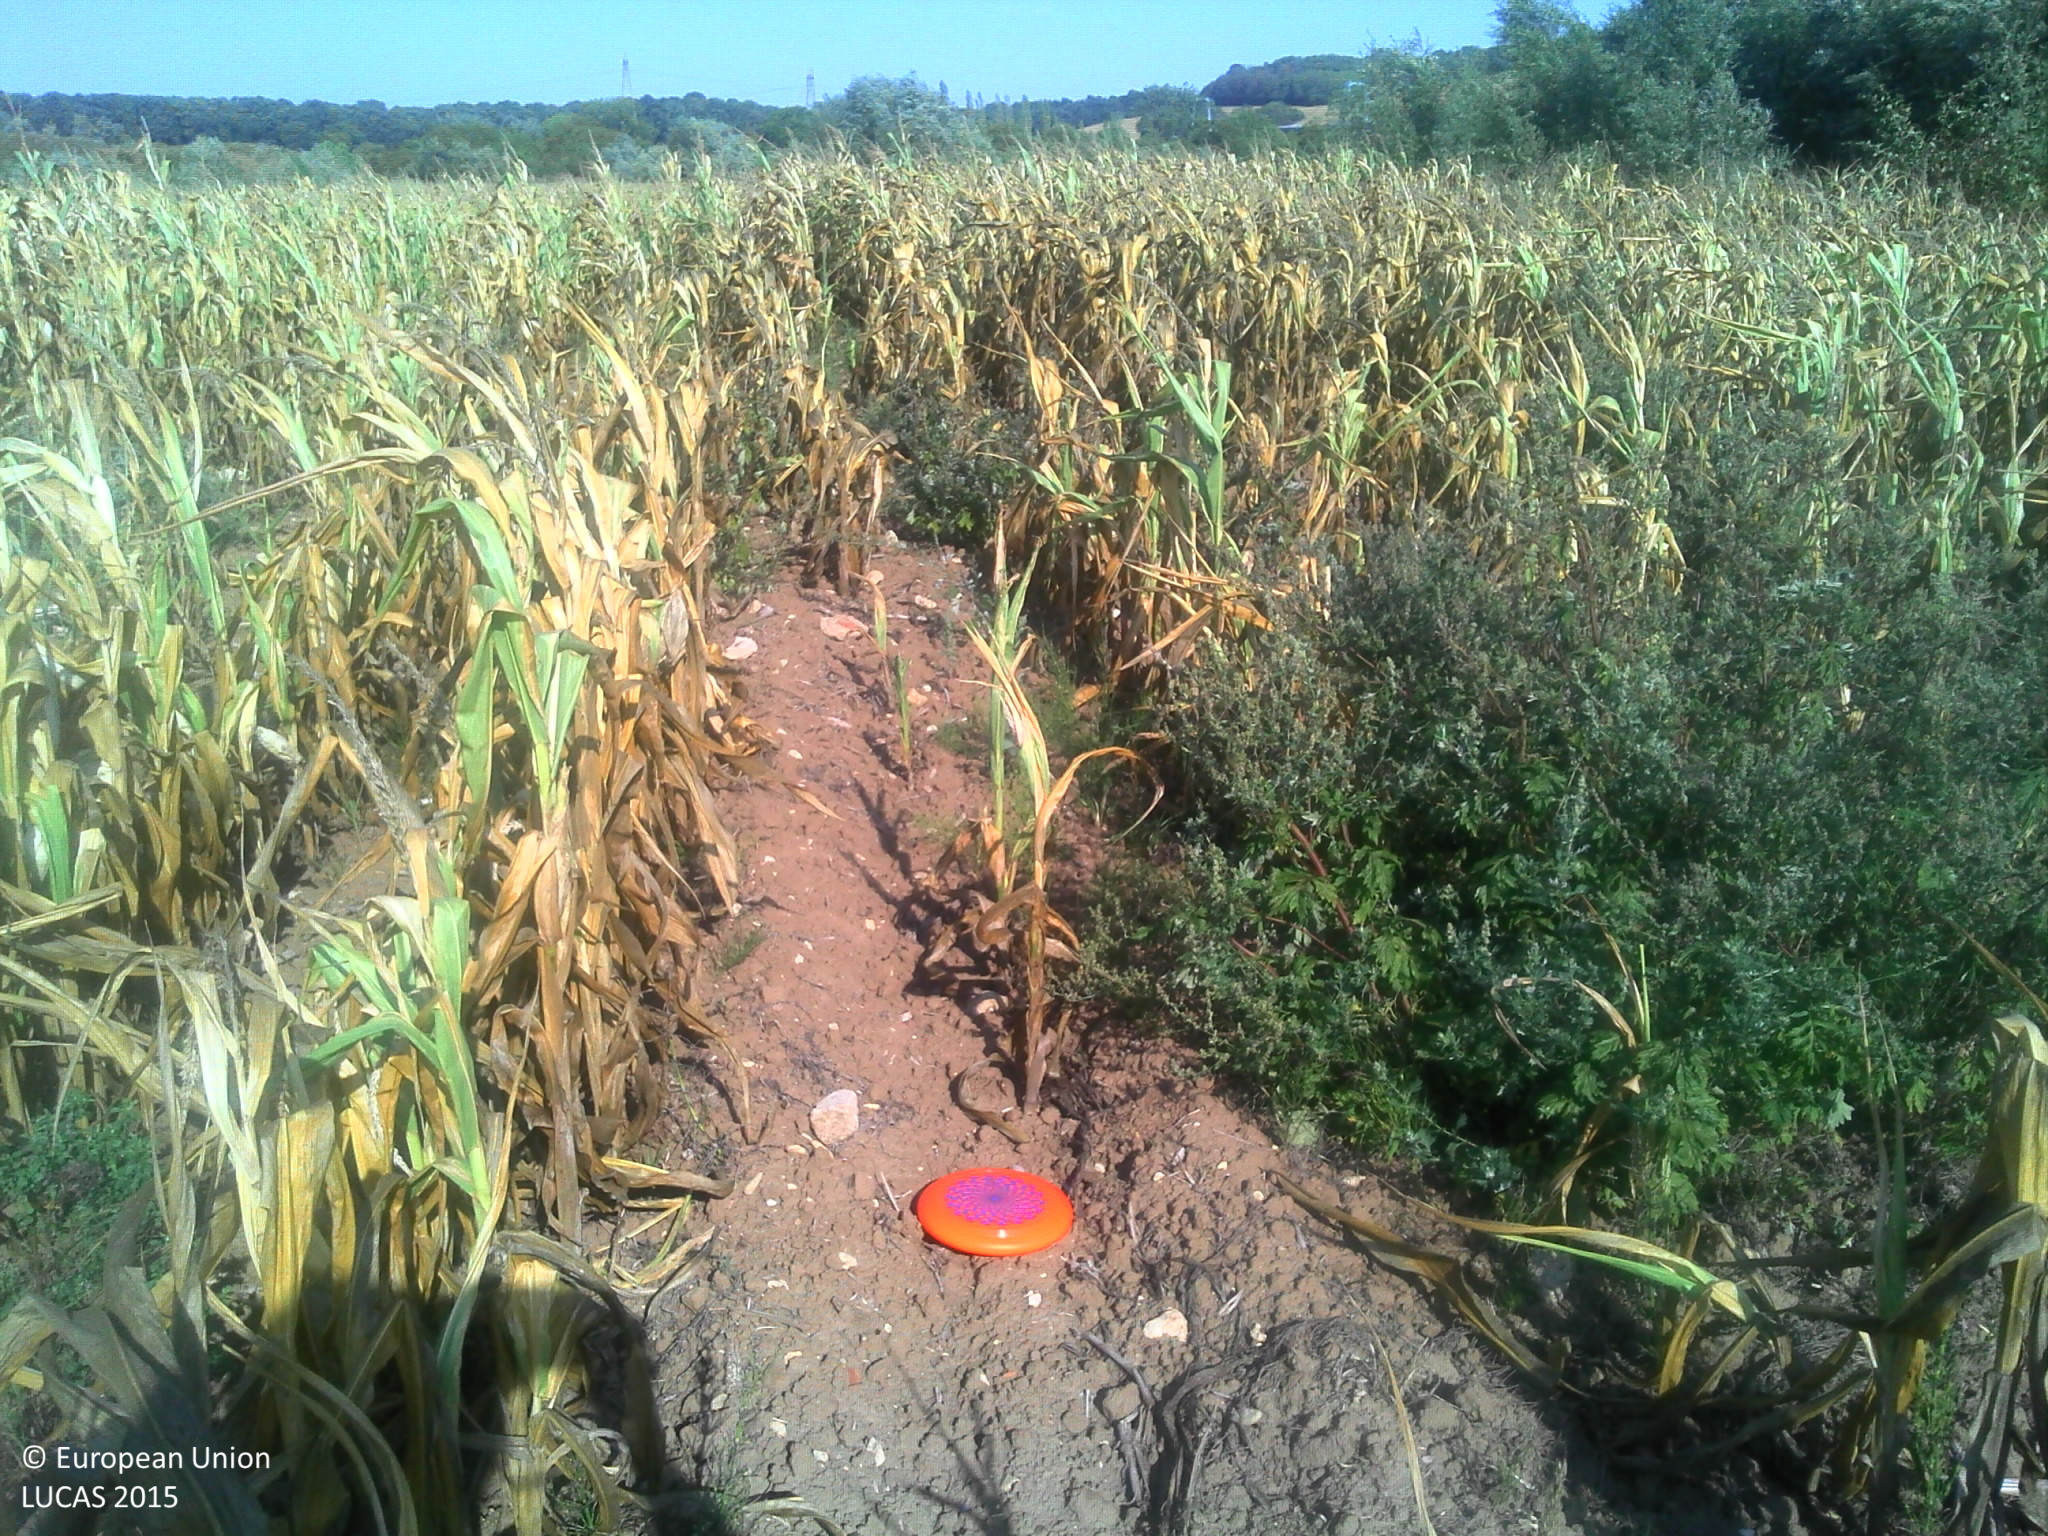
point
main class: Cropland
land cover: Maize
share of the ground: > 75 %
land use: Agriculture (excluding fallow land and kitchen gardens)
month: August
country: FR
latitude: 48.8746
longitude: 6.0866
